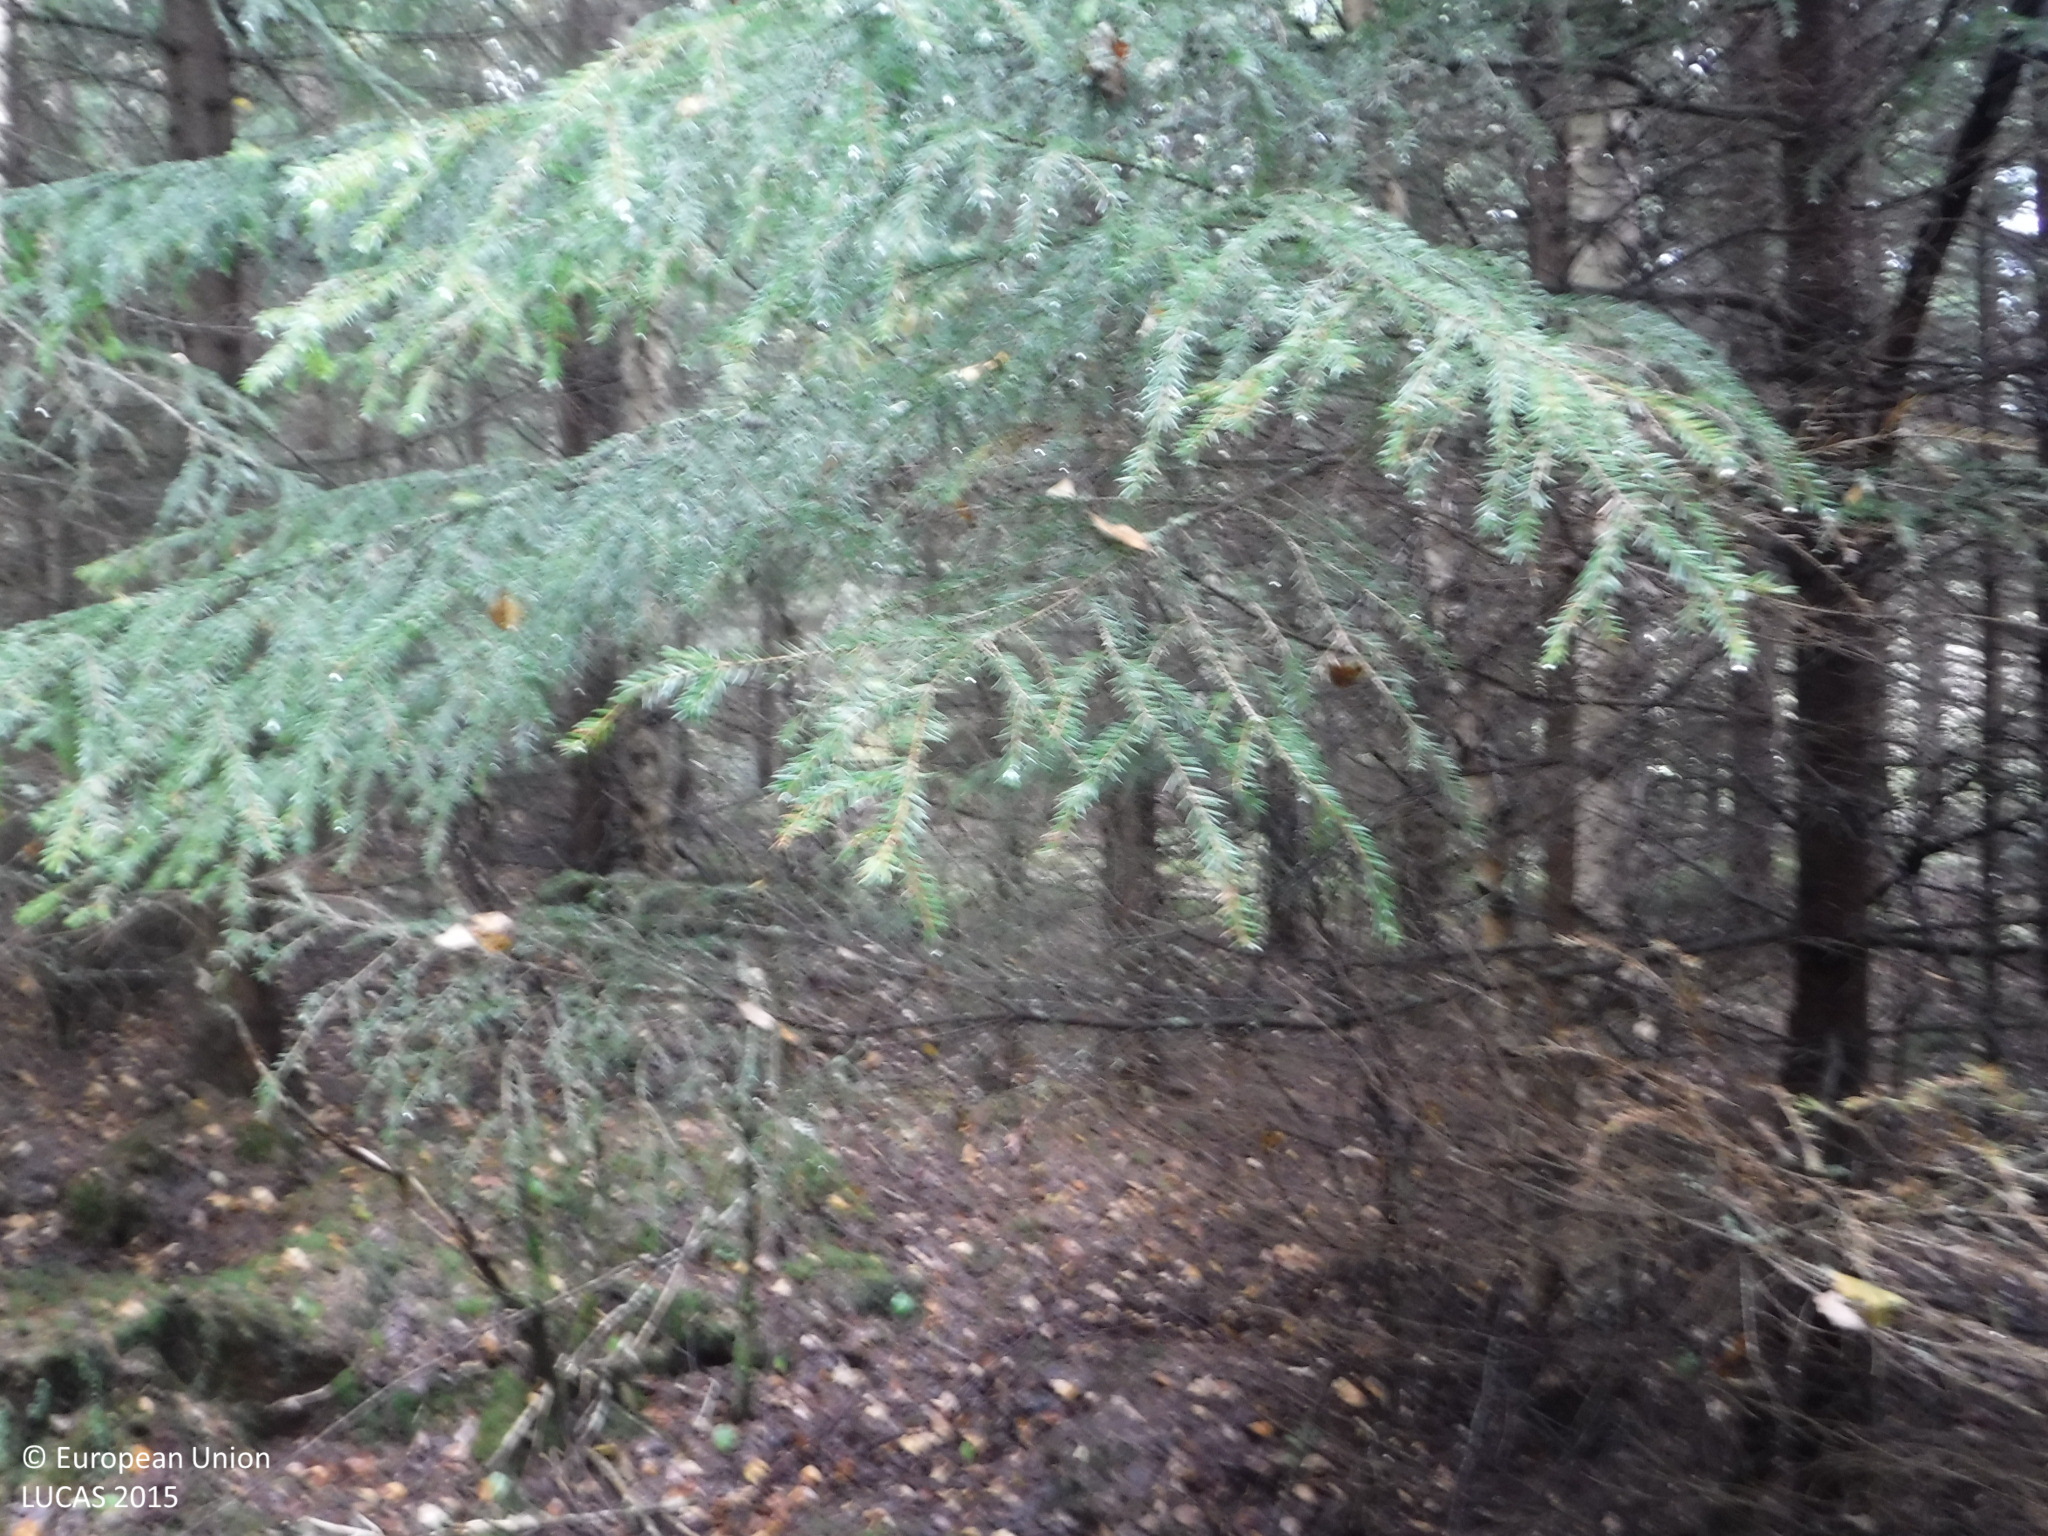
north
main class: Woodland
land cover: Spruce dominated coniferous woodland
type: boreal forest
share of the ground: > 75 %
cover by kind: coniferous forest trees 75 %, lichens and mosses 10 %, unconsolidated bare surface 10 %, broadleaved forest trees 5 %
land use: Forestry
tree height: > 5 m
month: September
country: FI
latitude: 61.2988
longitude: 23.1603
